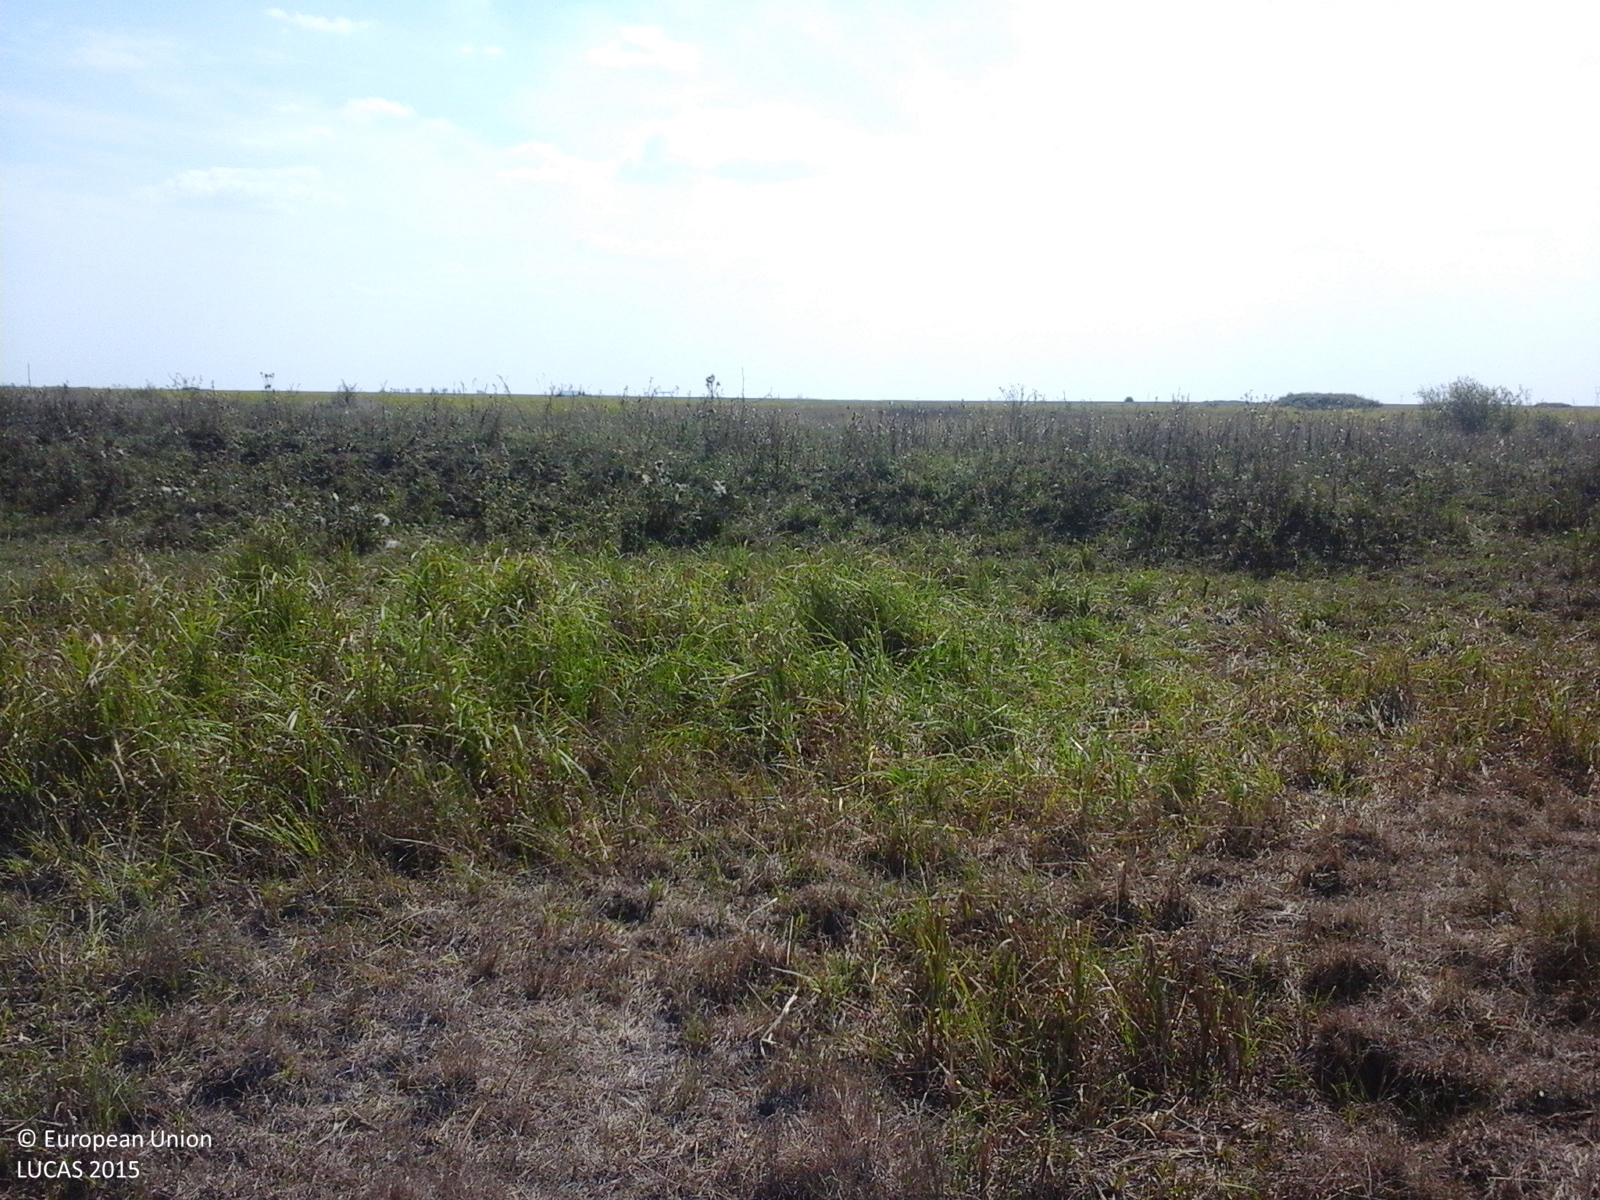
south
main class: Grassland
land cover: Grassland without tree/shrub cover
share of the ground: > 75 %
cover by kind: herbaceous plants 100 %
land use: Agriculture (excluding fallow land and kitchen gardens)
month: August
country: RO
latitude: 46.4169
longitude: 21.5259
